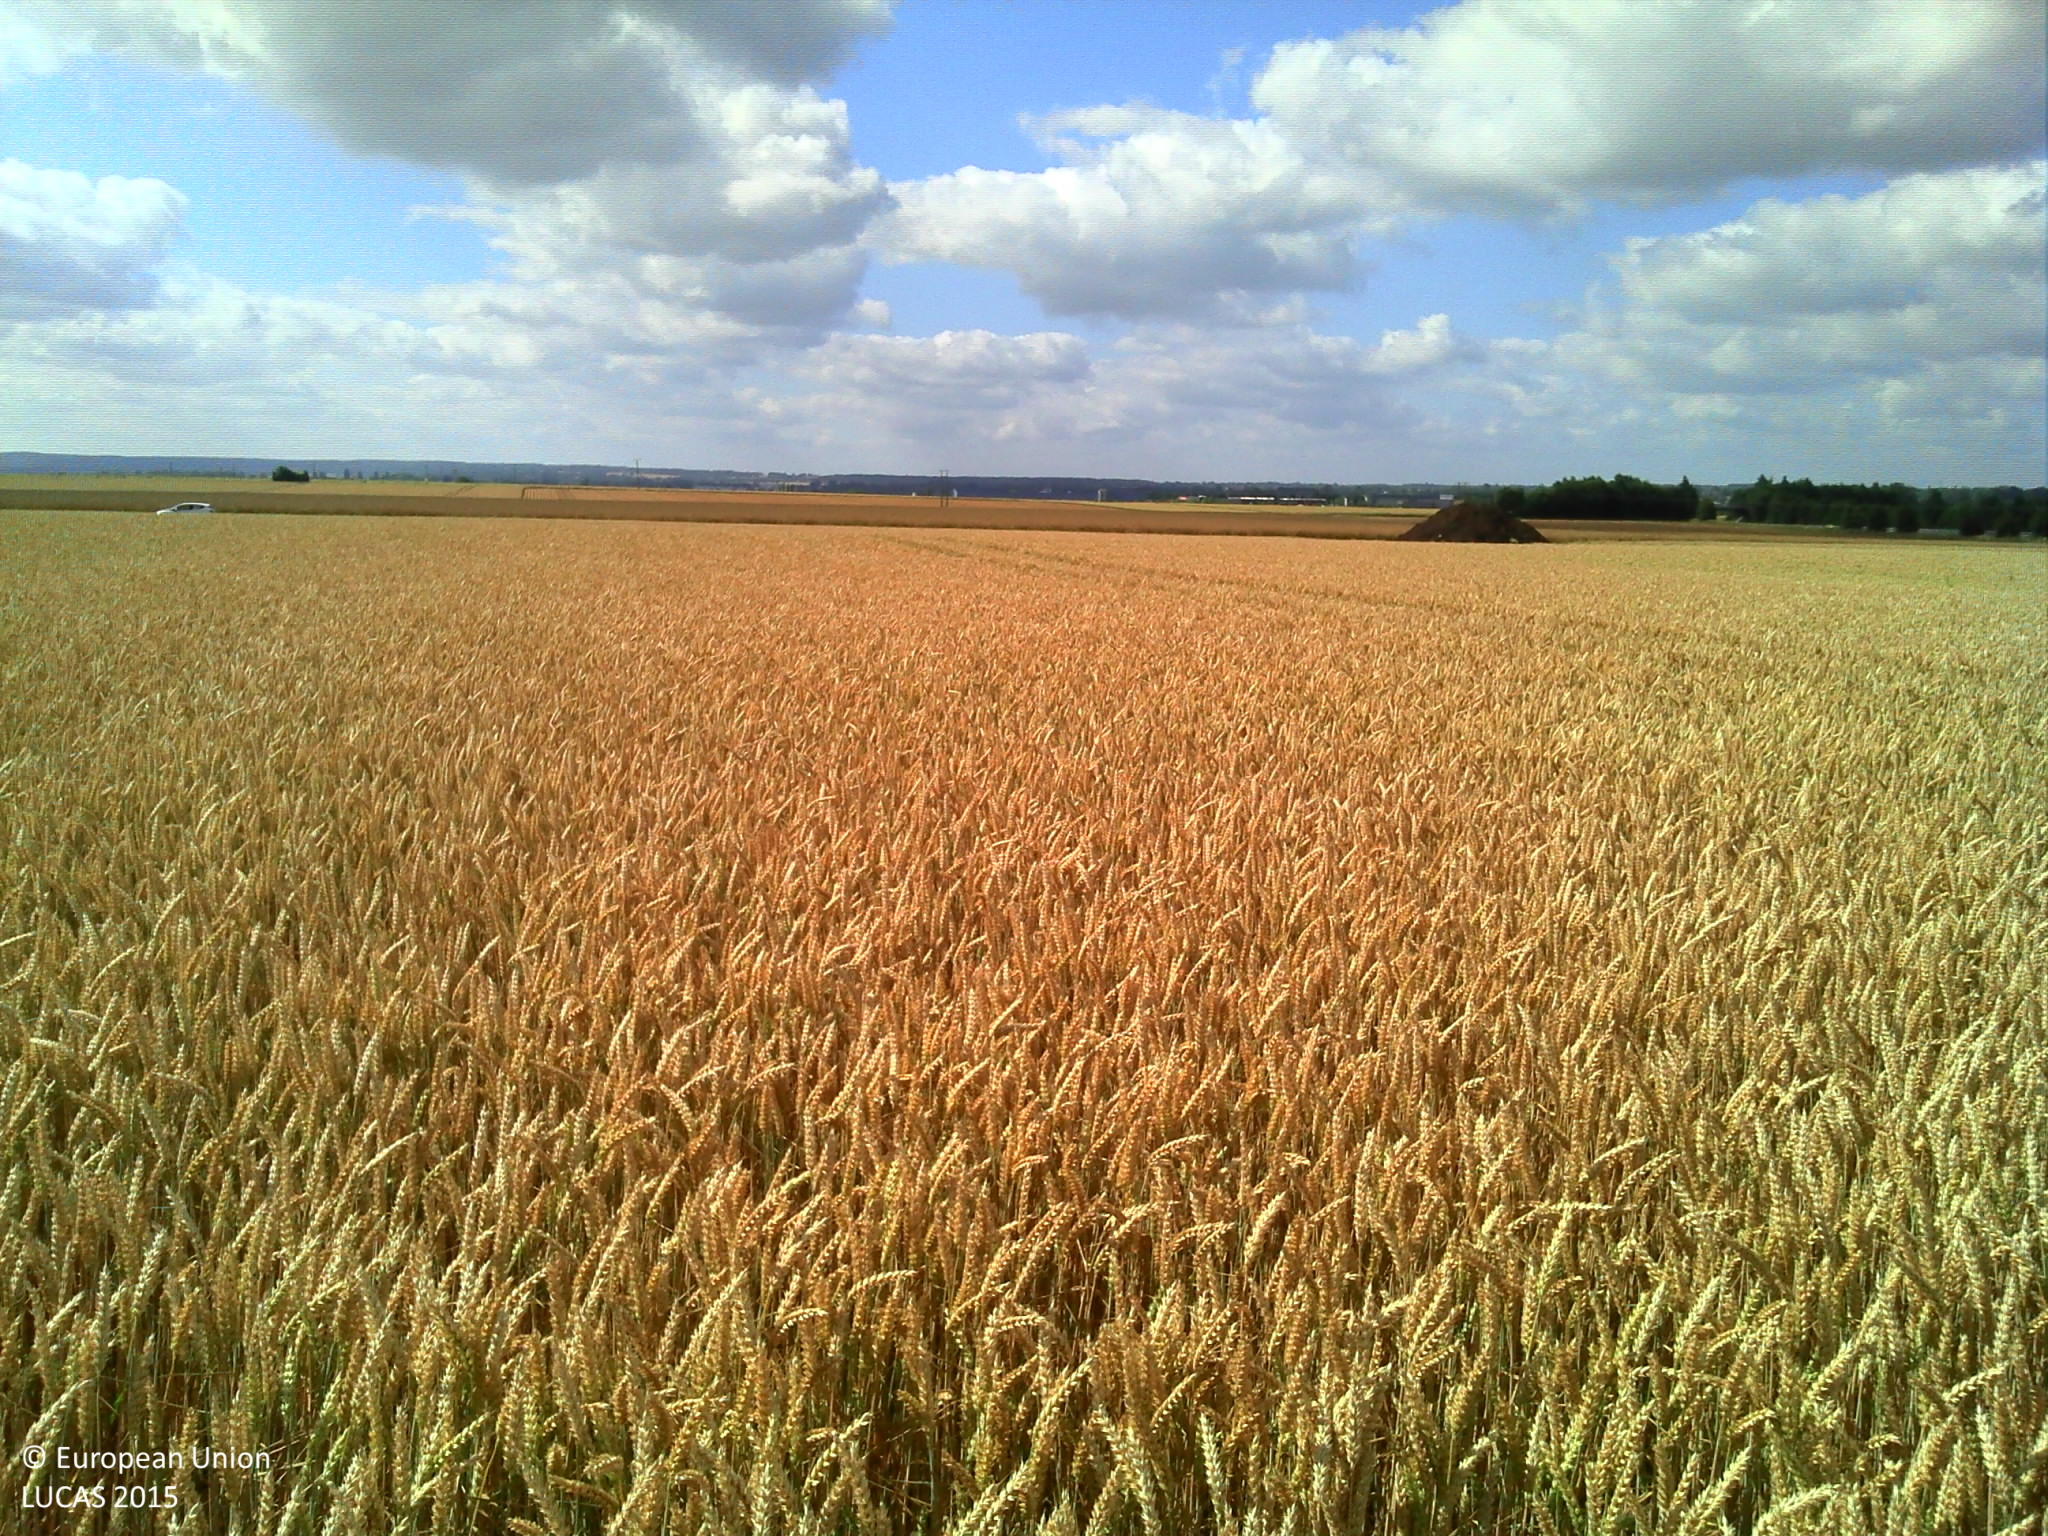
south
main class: Cropland
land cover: Common wheat
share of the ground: > 75 %
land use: Agriculture (excluding fallow land and kitchen gardens)
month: July
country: FR
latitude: 48.9278
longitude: -0.2012
